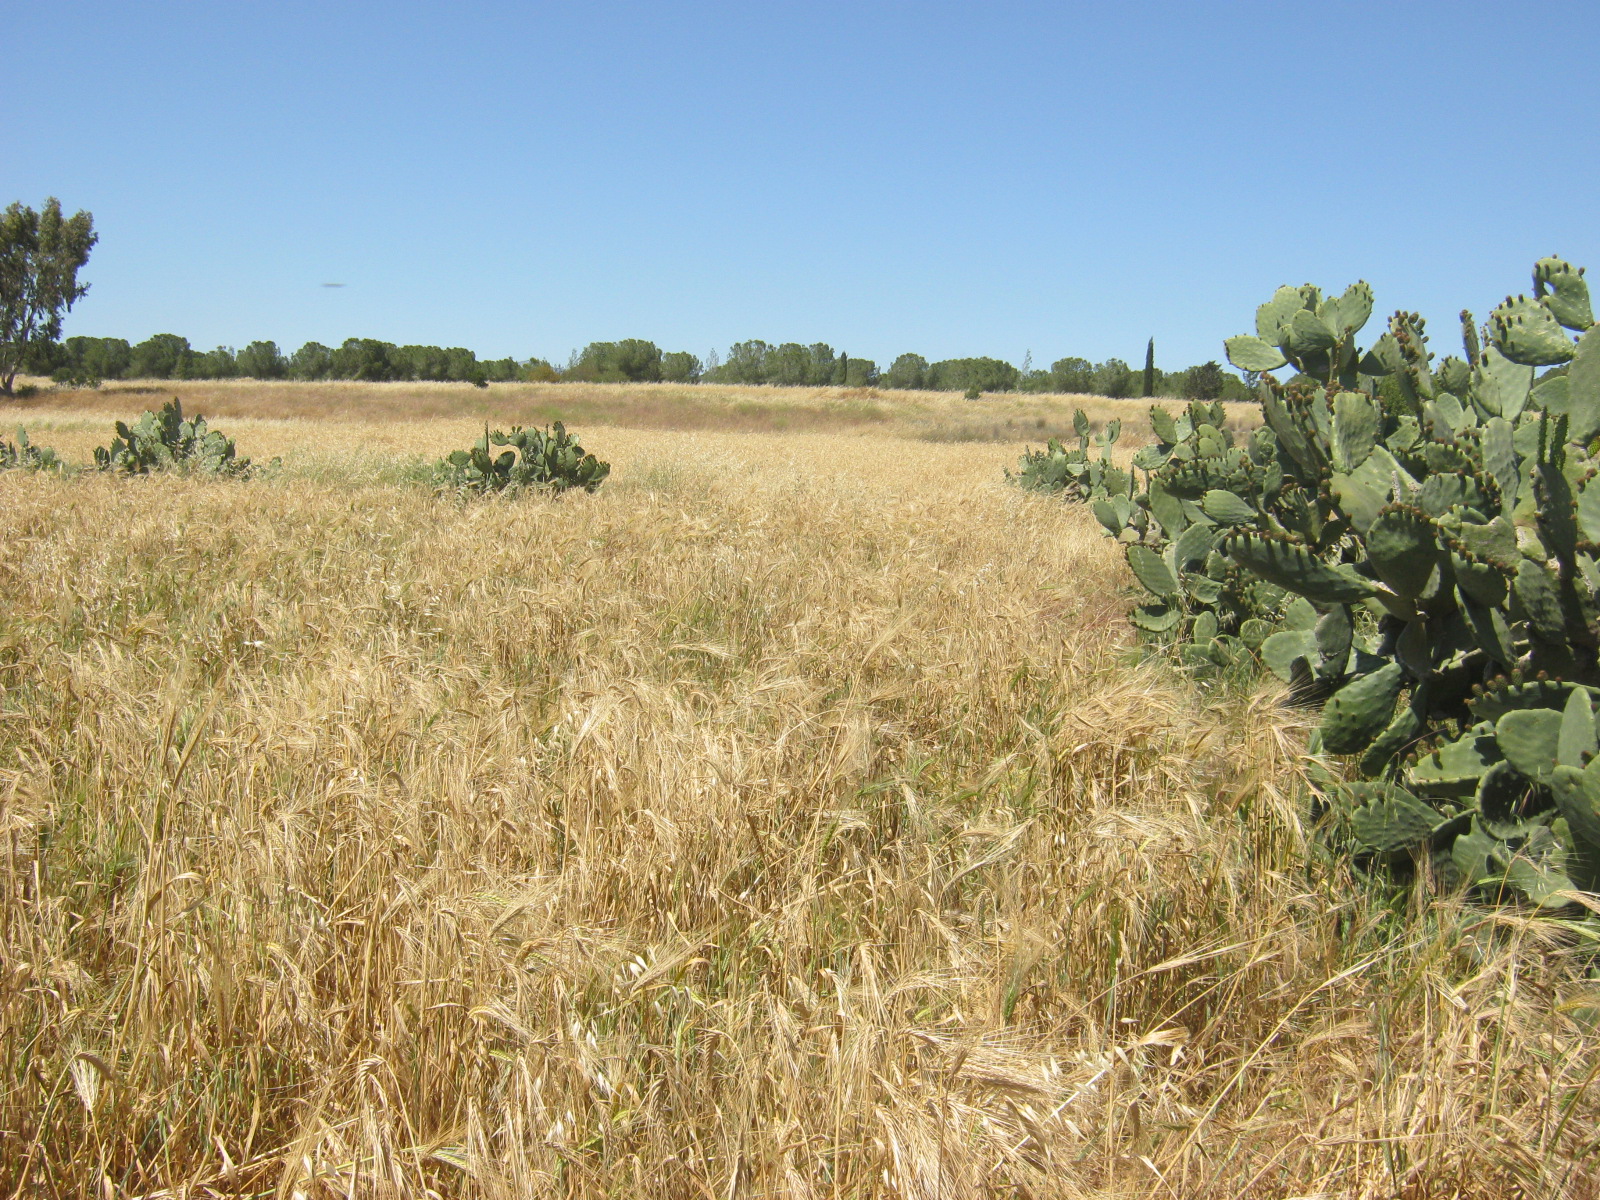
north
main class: Cropland
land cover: Mixed cereals for fodder
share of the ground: > 75 %
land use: Agriculture (excluding fallow land and kitchen gardens)
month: May
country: CY
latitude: 35.1418
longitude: 33.1799
